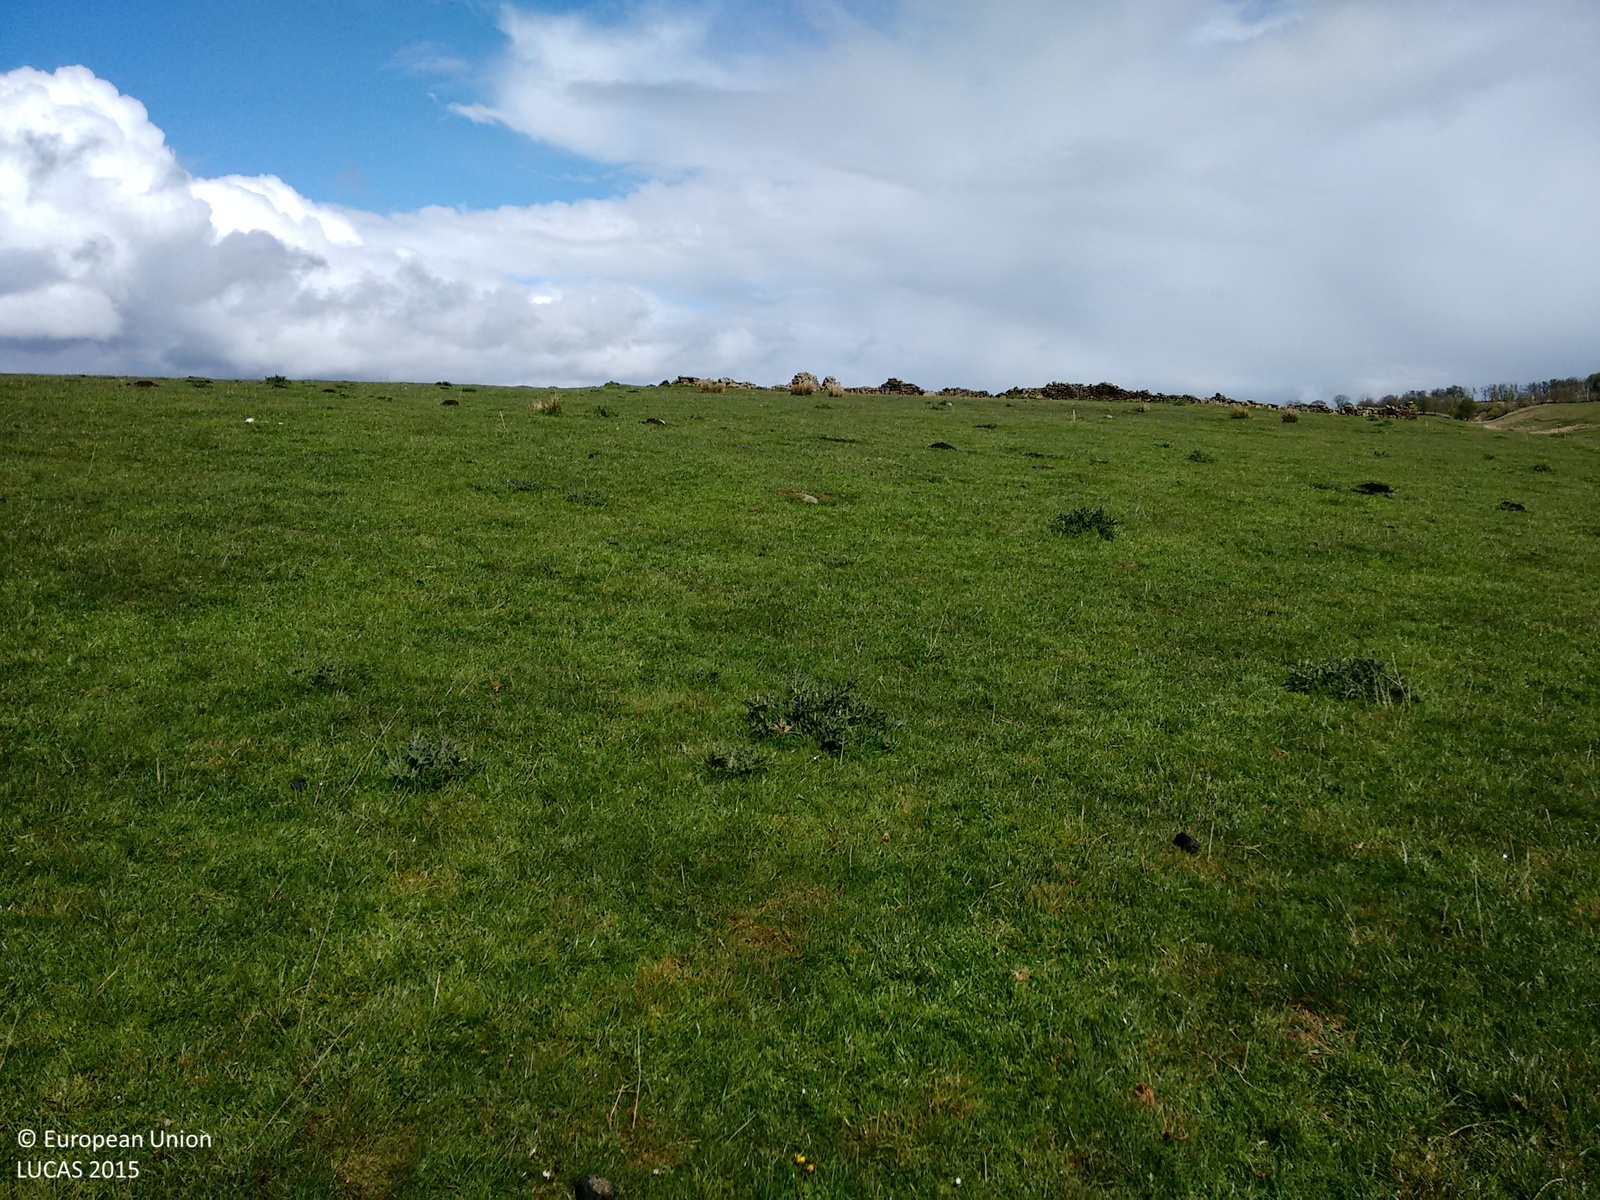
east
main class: Grassland
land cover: Grassland without tree/shrub cover
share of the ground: > 75 %
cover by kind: herbaceous plants 100 %
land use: Agriculture (excluding fallow land and kitchen gardens)
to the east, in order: Grassland without tree/shrub cover
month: May
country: GB
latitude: 54.9957
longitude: -2.2668
